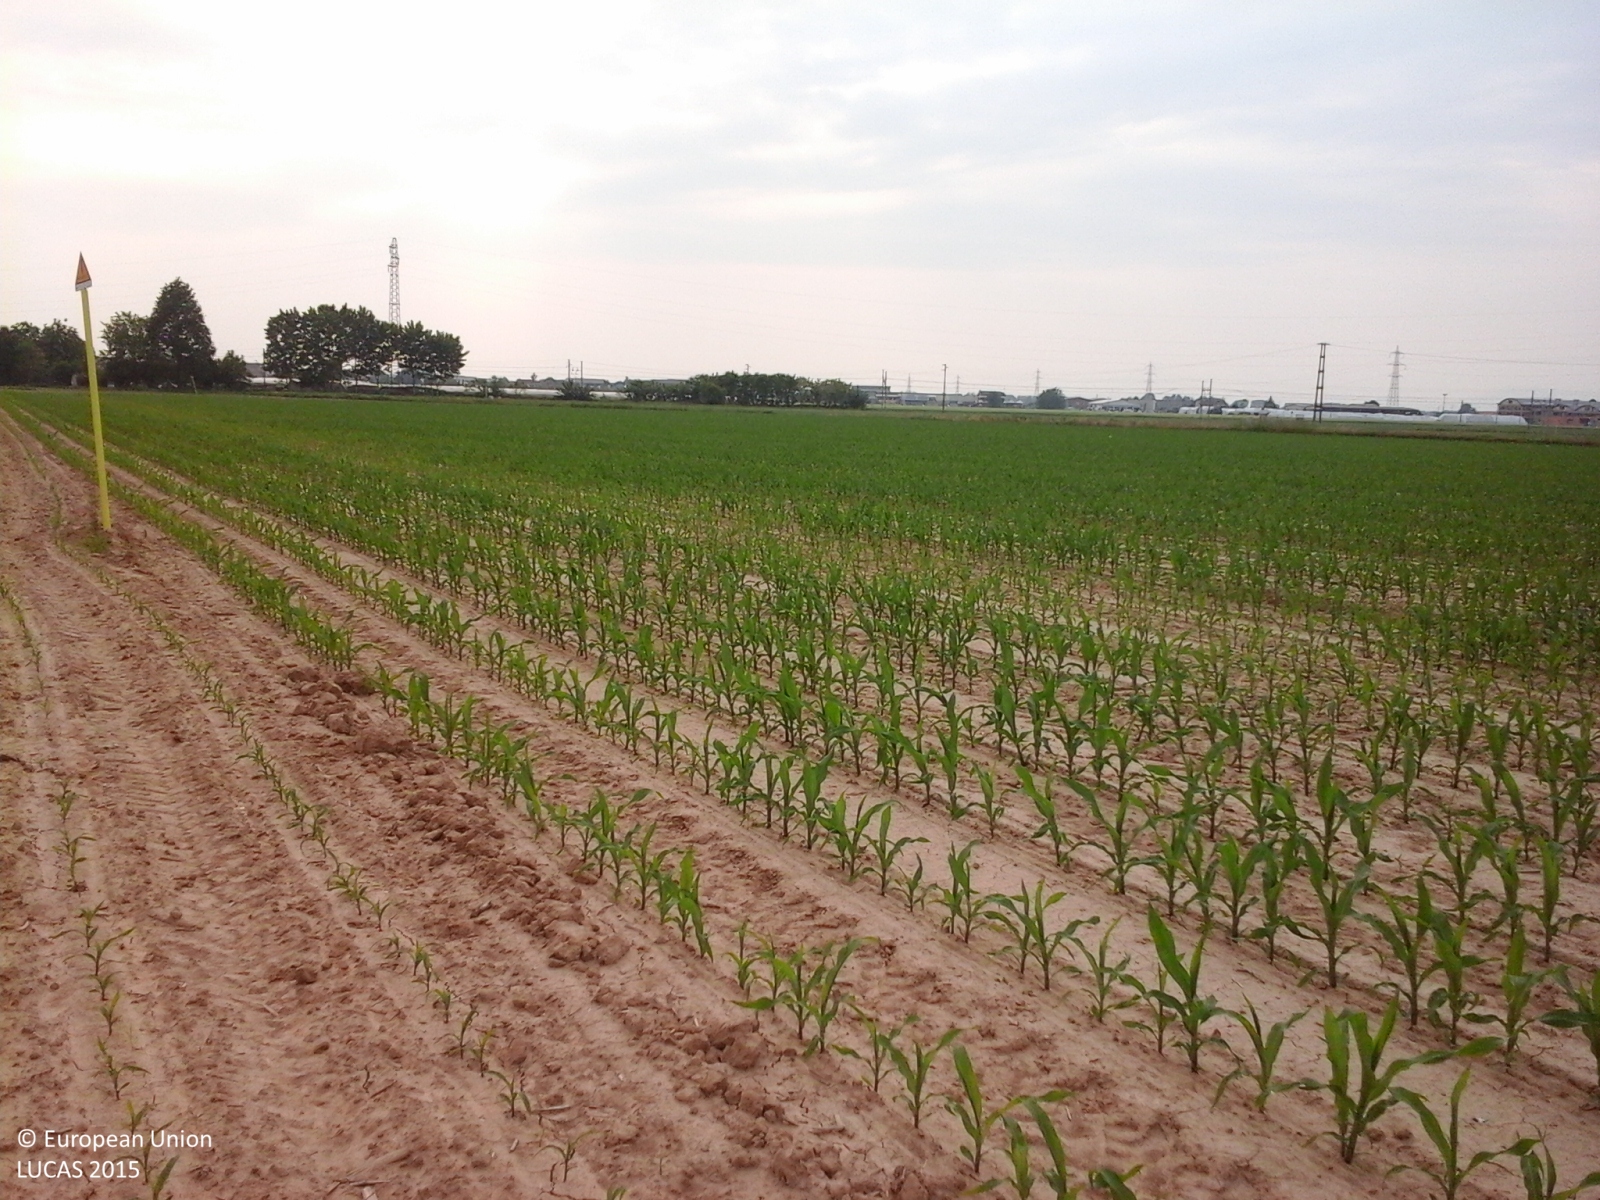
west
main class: Cropland
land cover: Maize
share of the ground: < 10 %
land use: Agriculture (excluding fallow land and kitchen gardens)
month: May
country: IT
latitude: 44.8671
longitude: 7.7387
